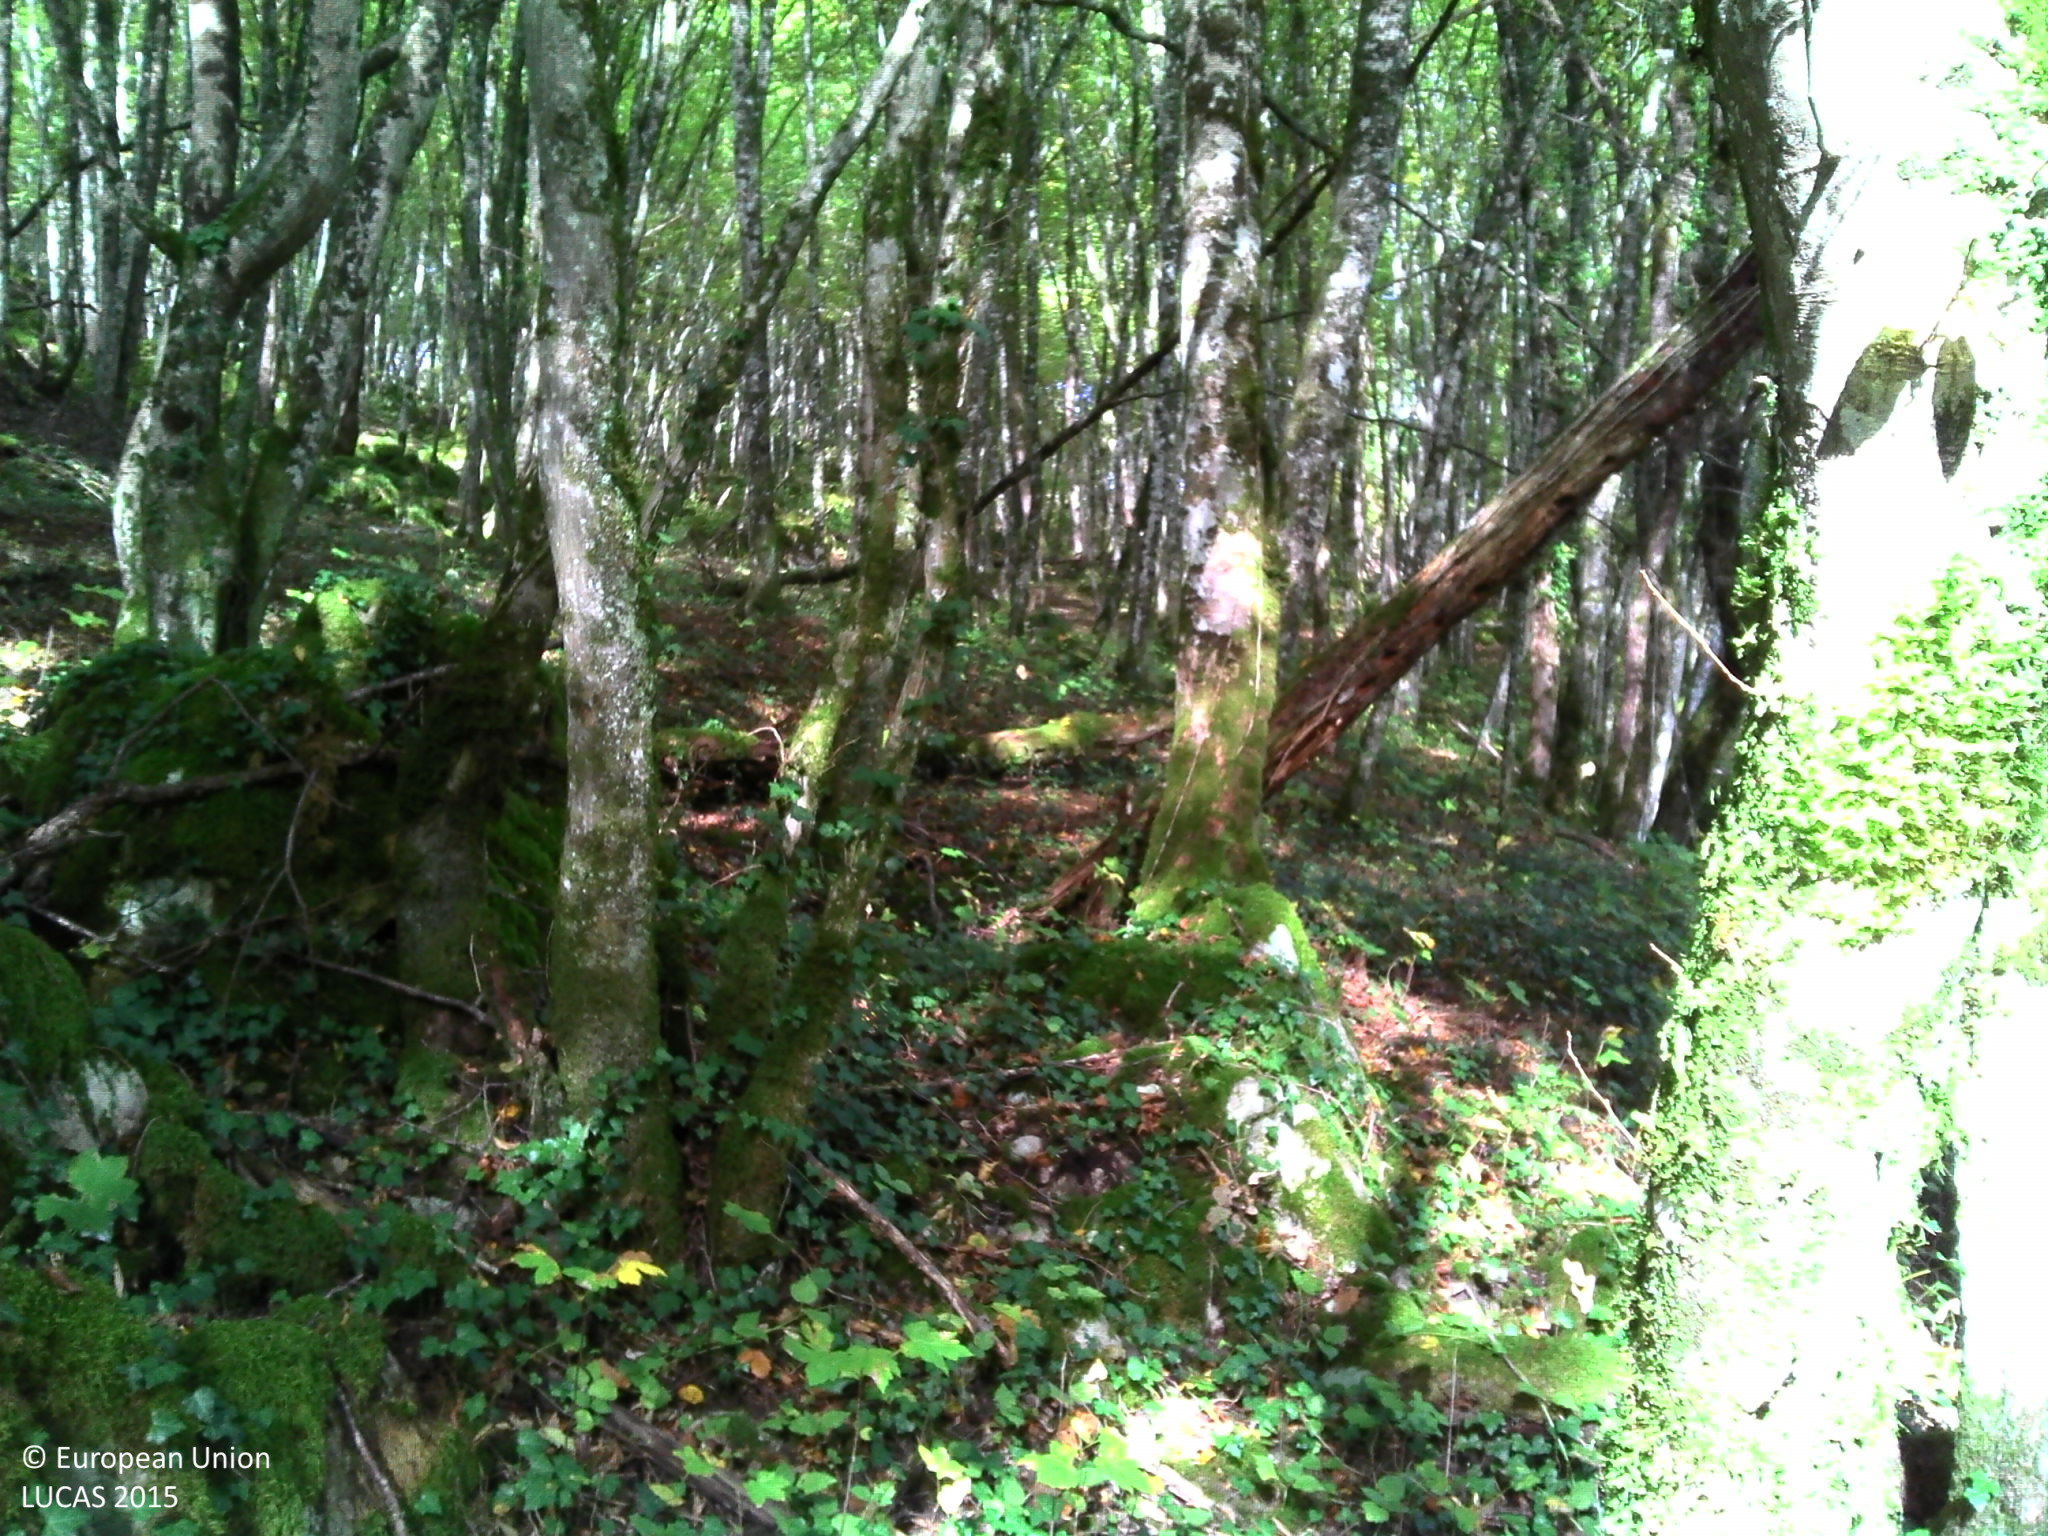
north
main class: Woodland
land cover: Broadleaved woodland
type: mesophytic deciduous forest
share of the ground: > 75 %
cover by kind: broadleaved forest trees 90 %, lichens and mosses 5 %, consolidated bare surface 5 %
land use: Forestry
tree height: > 5 m
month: October
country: FR
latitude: 47.0436
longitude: 6.2774
